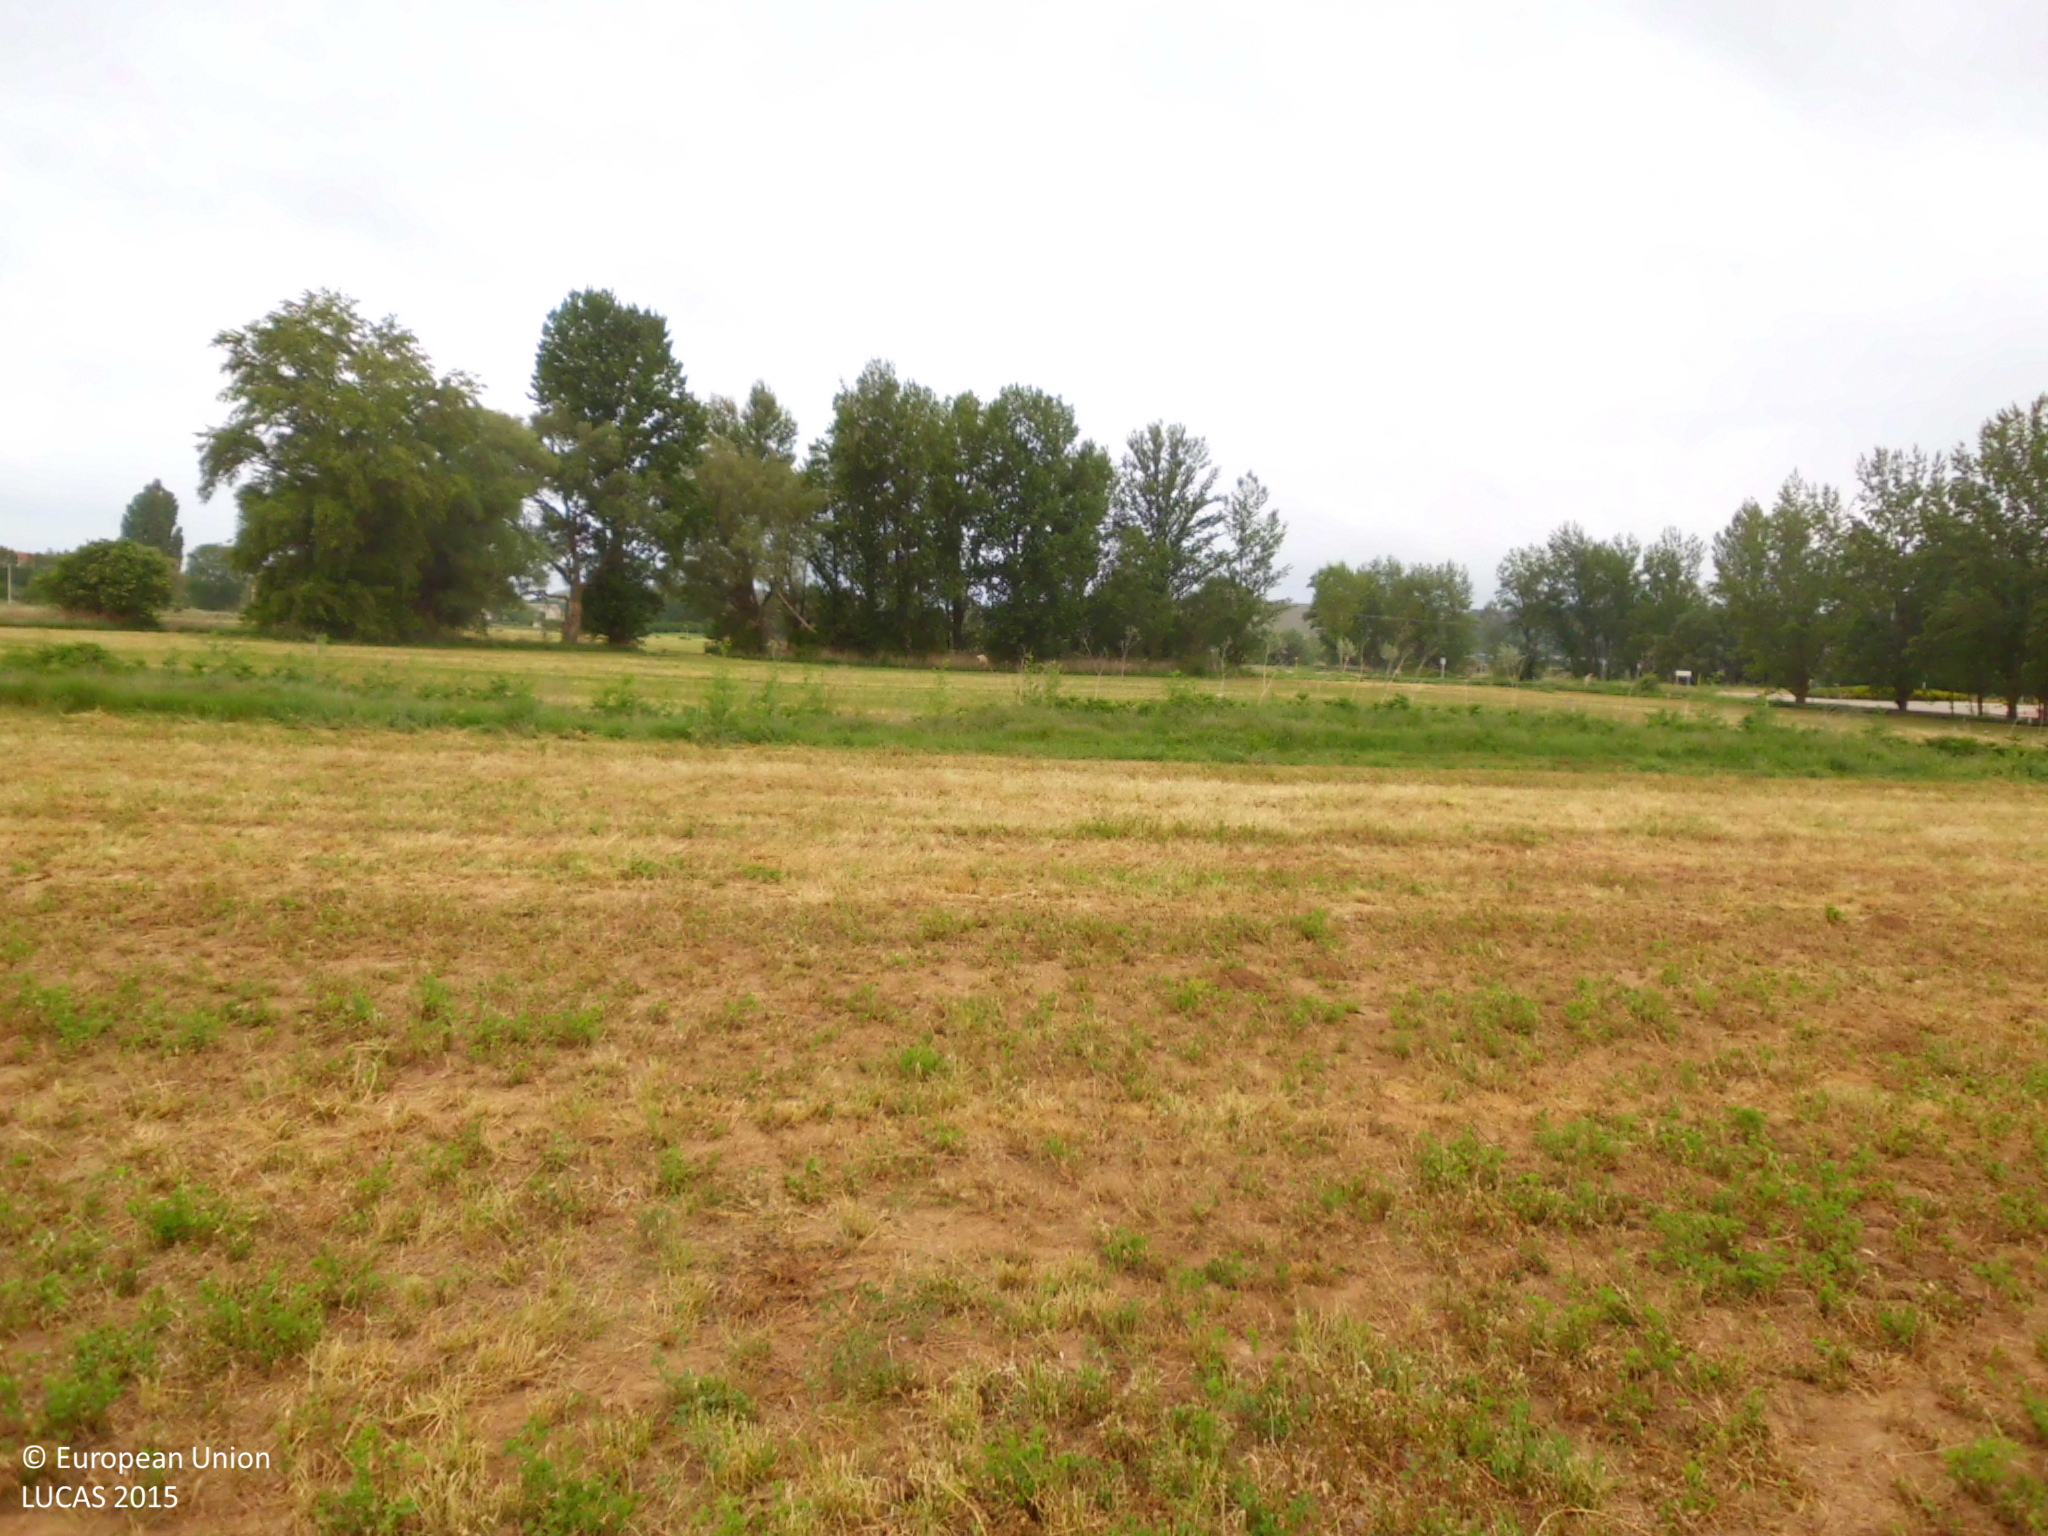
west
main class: Cropland
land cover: Lucerne
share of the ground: 25 - 50 %
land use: Agriculture (excluding fallow land and kitchen gardens)
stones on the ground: < 10 %
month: May
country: ES
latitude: 42.3492
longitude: -3.7670
